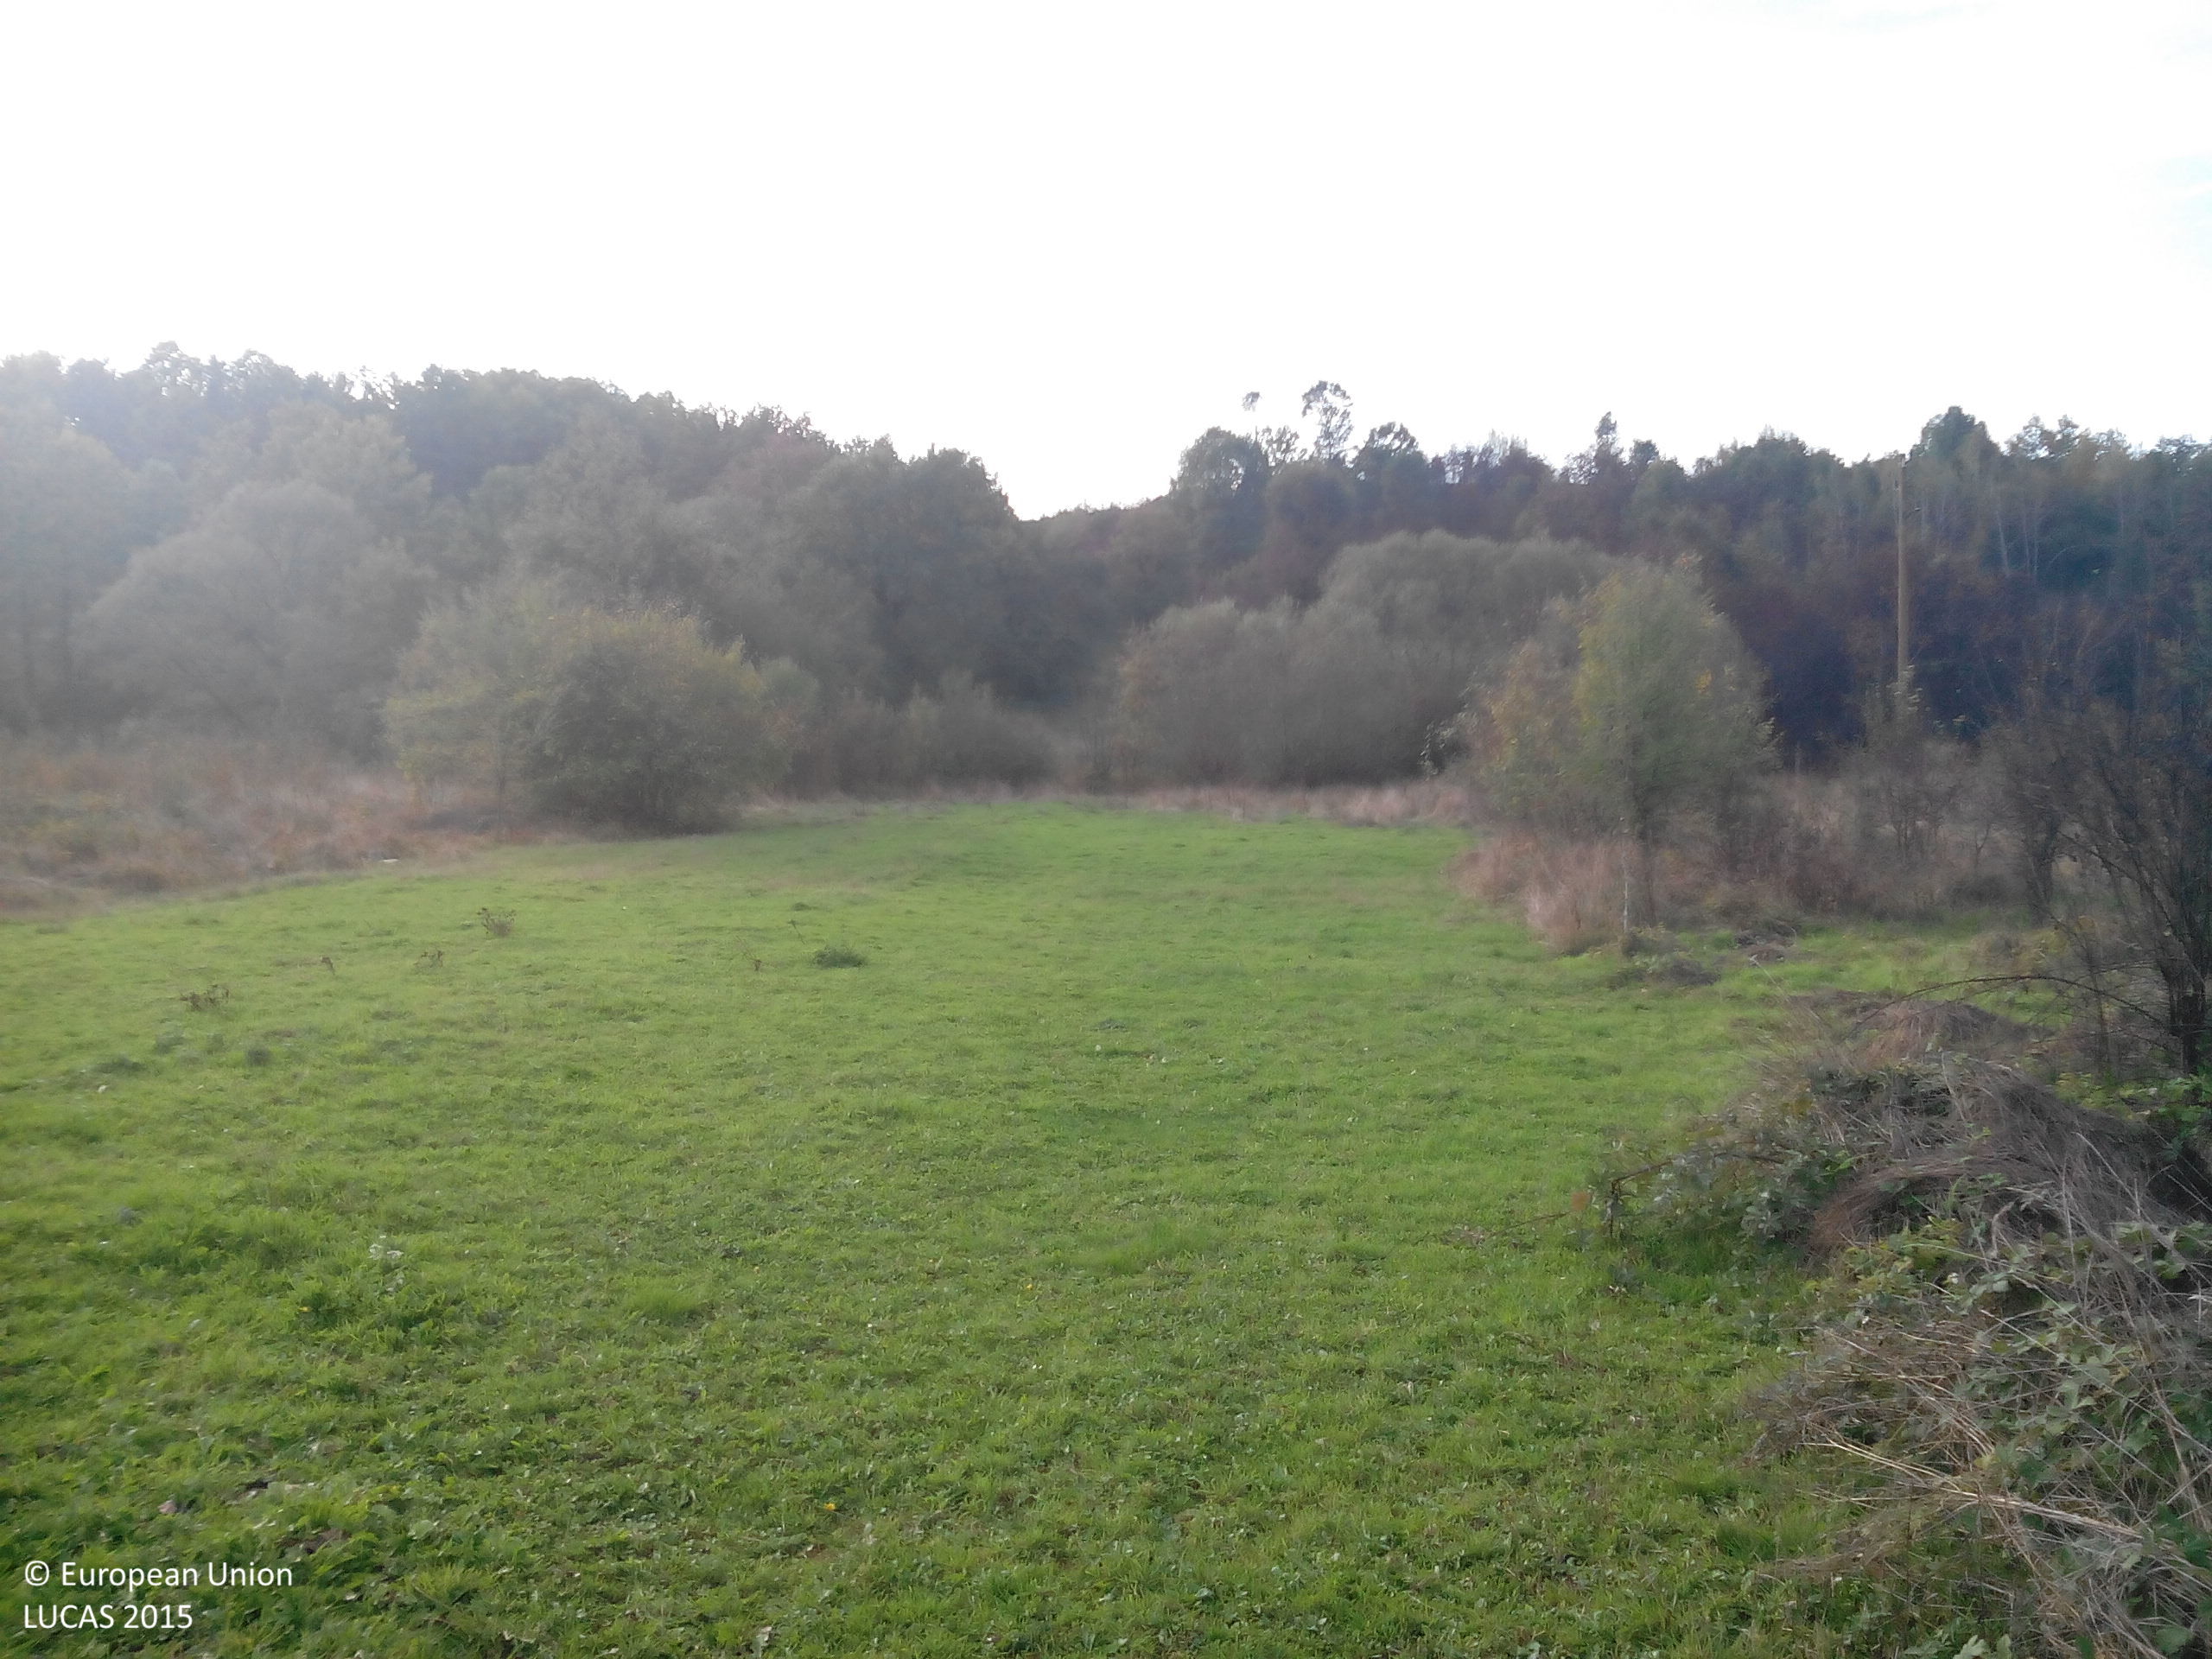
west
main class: Grassland
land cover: Grassland without tree/shrub cover
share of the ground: > 75 %
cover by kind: herbaceous plants 95 %, shrubs 5 %
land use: Agriculture (excluding fallow land and kitchen gardens)
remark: Harvested field
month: October
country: BG
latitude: 42.9103
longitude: 24.0731
